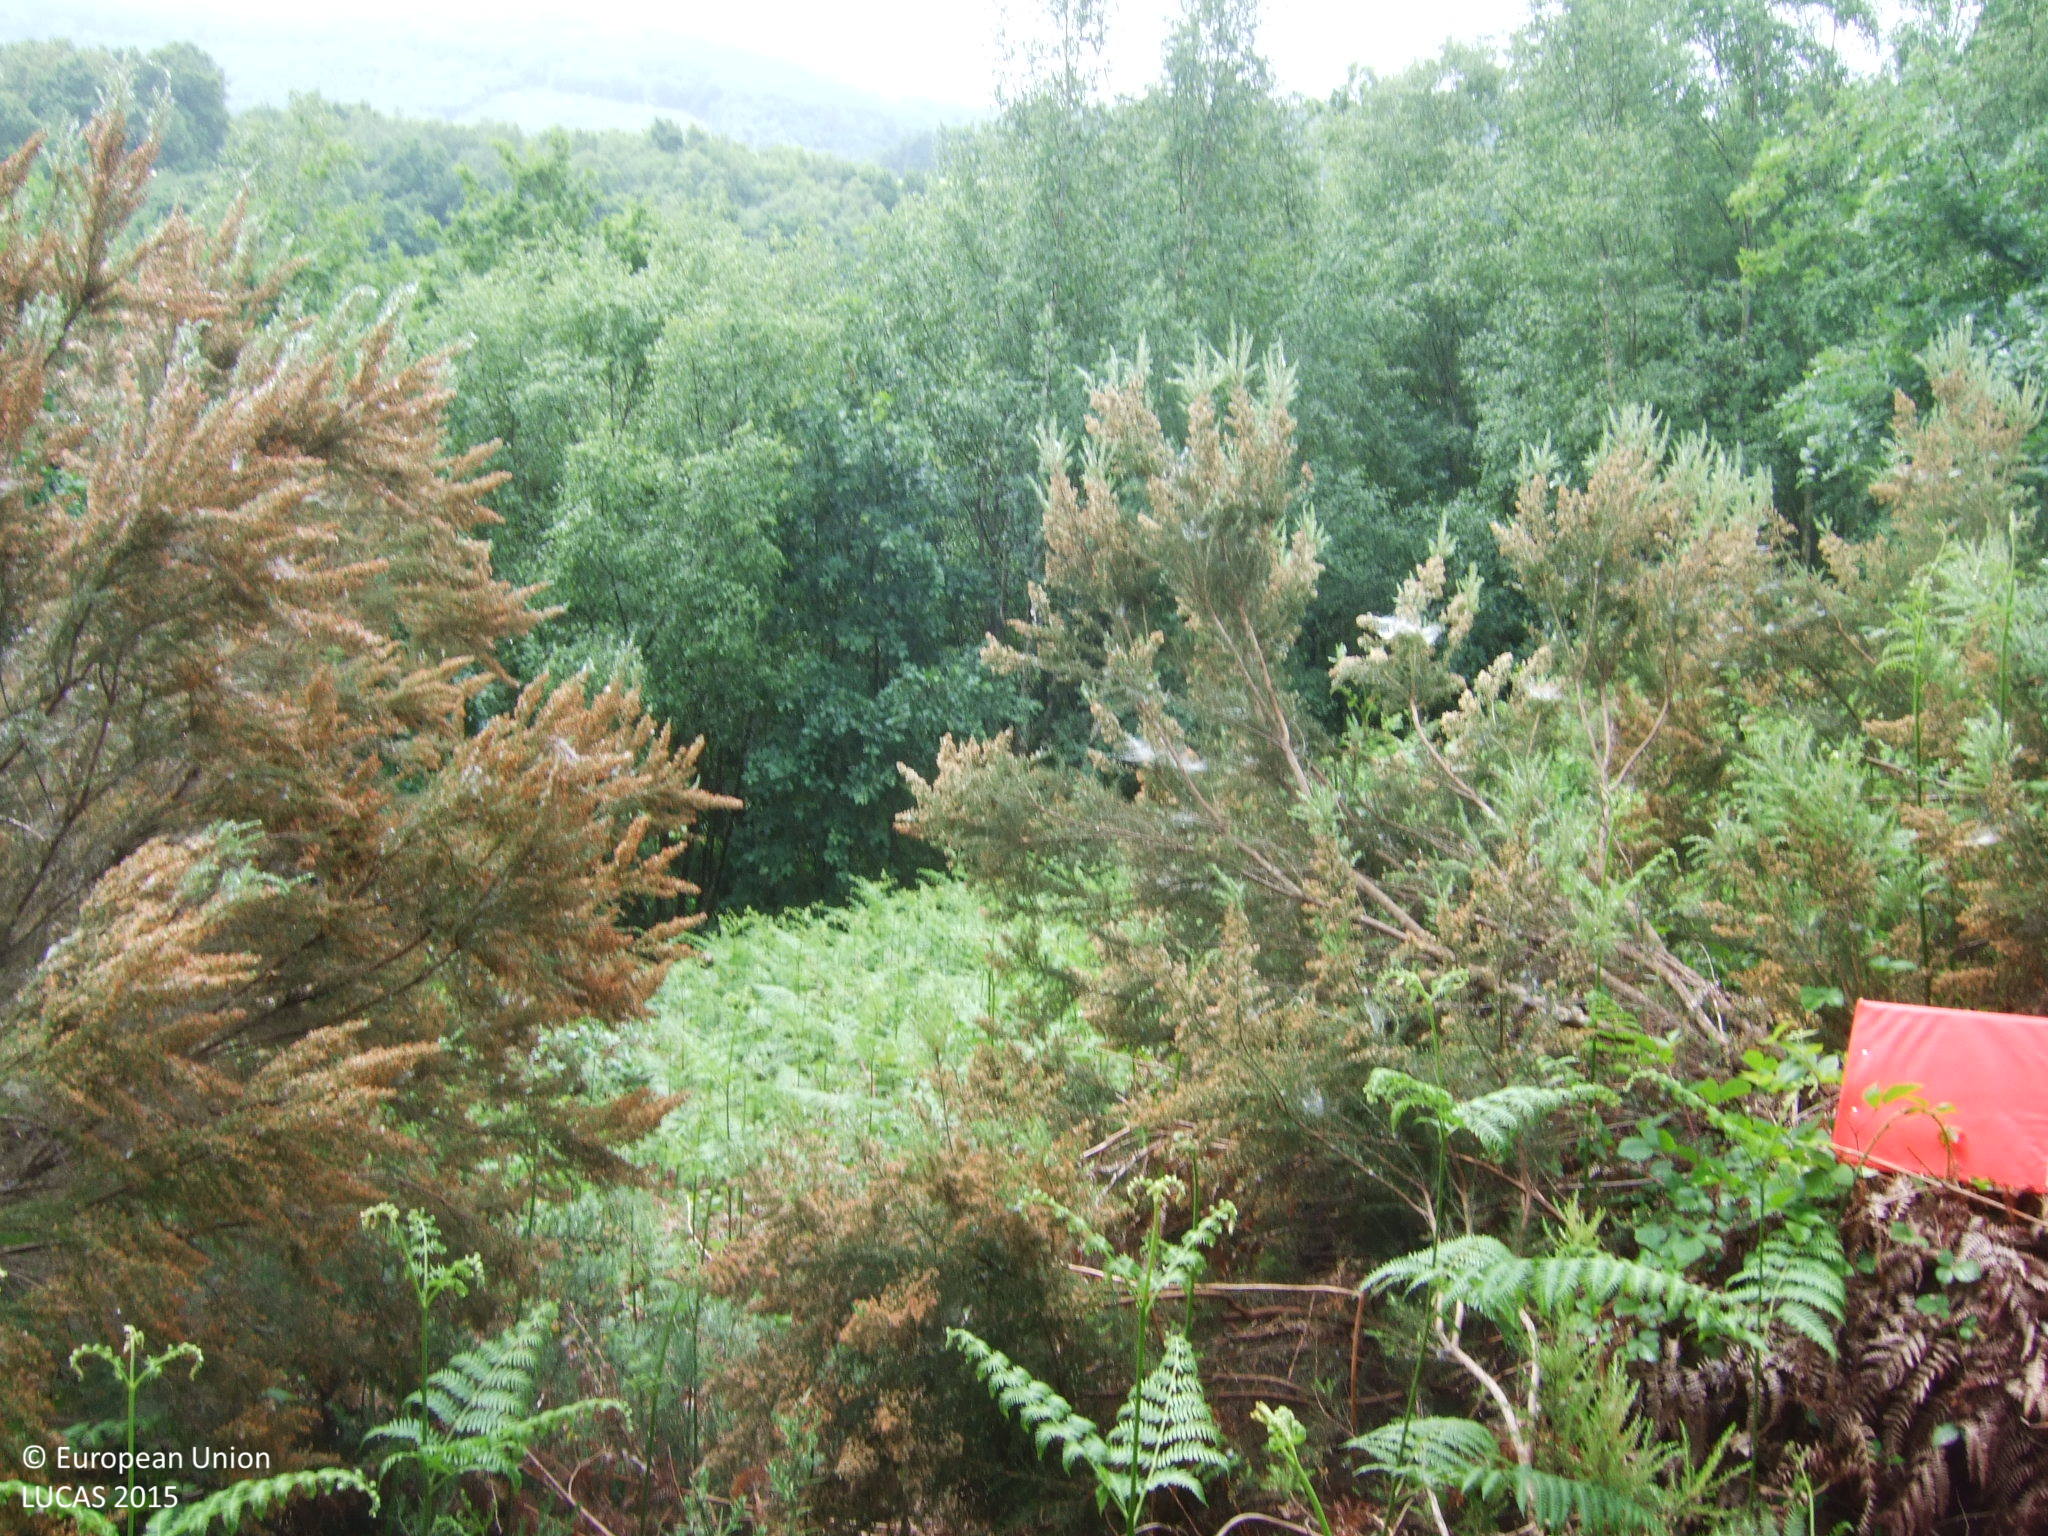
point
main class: Shrubland
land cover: Shrubland with sparse tree cover
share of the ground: > 75 %
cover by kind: shrubs 95 %, broadleaved forest trees 5 %
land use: Semi-natural and natural areas not in use
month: June
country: ES
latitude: 42.7280
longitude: -7.3494
